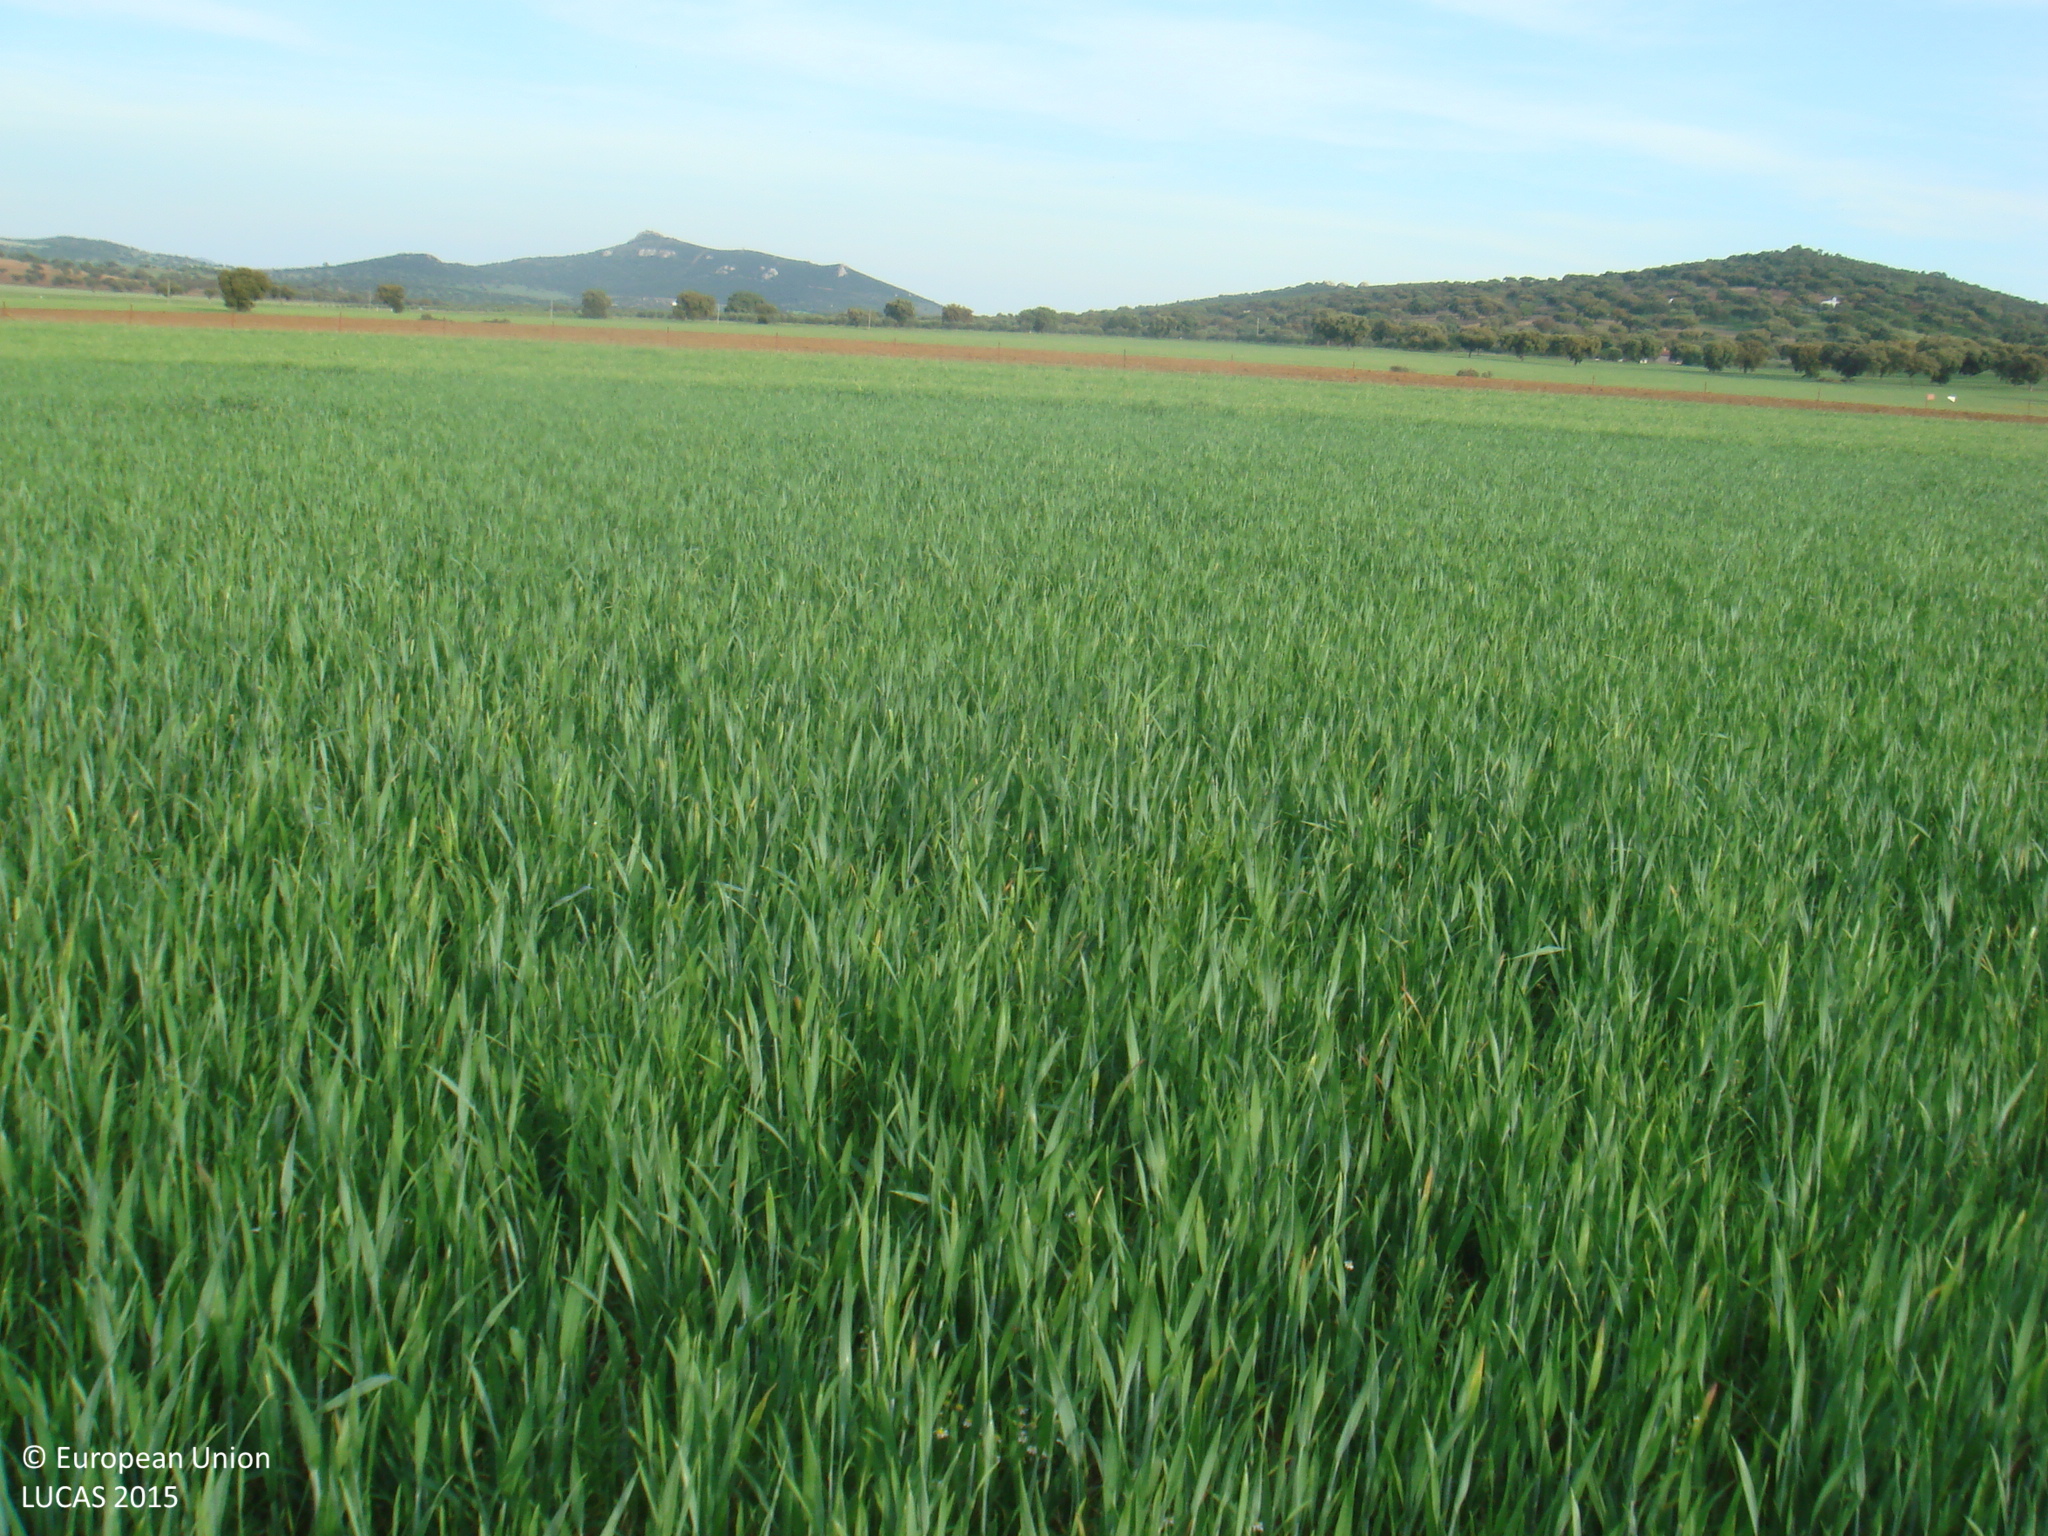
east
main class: Cropland
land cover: Durum wheat
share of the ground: > 75 %
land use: Agriculture (excluding fallow land and kitchen gardens)
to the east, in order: Durum wheat; Fences; Other bare soil
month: April
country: ES
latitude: 38.3521
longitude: -5.3527
